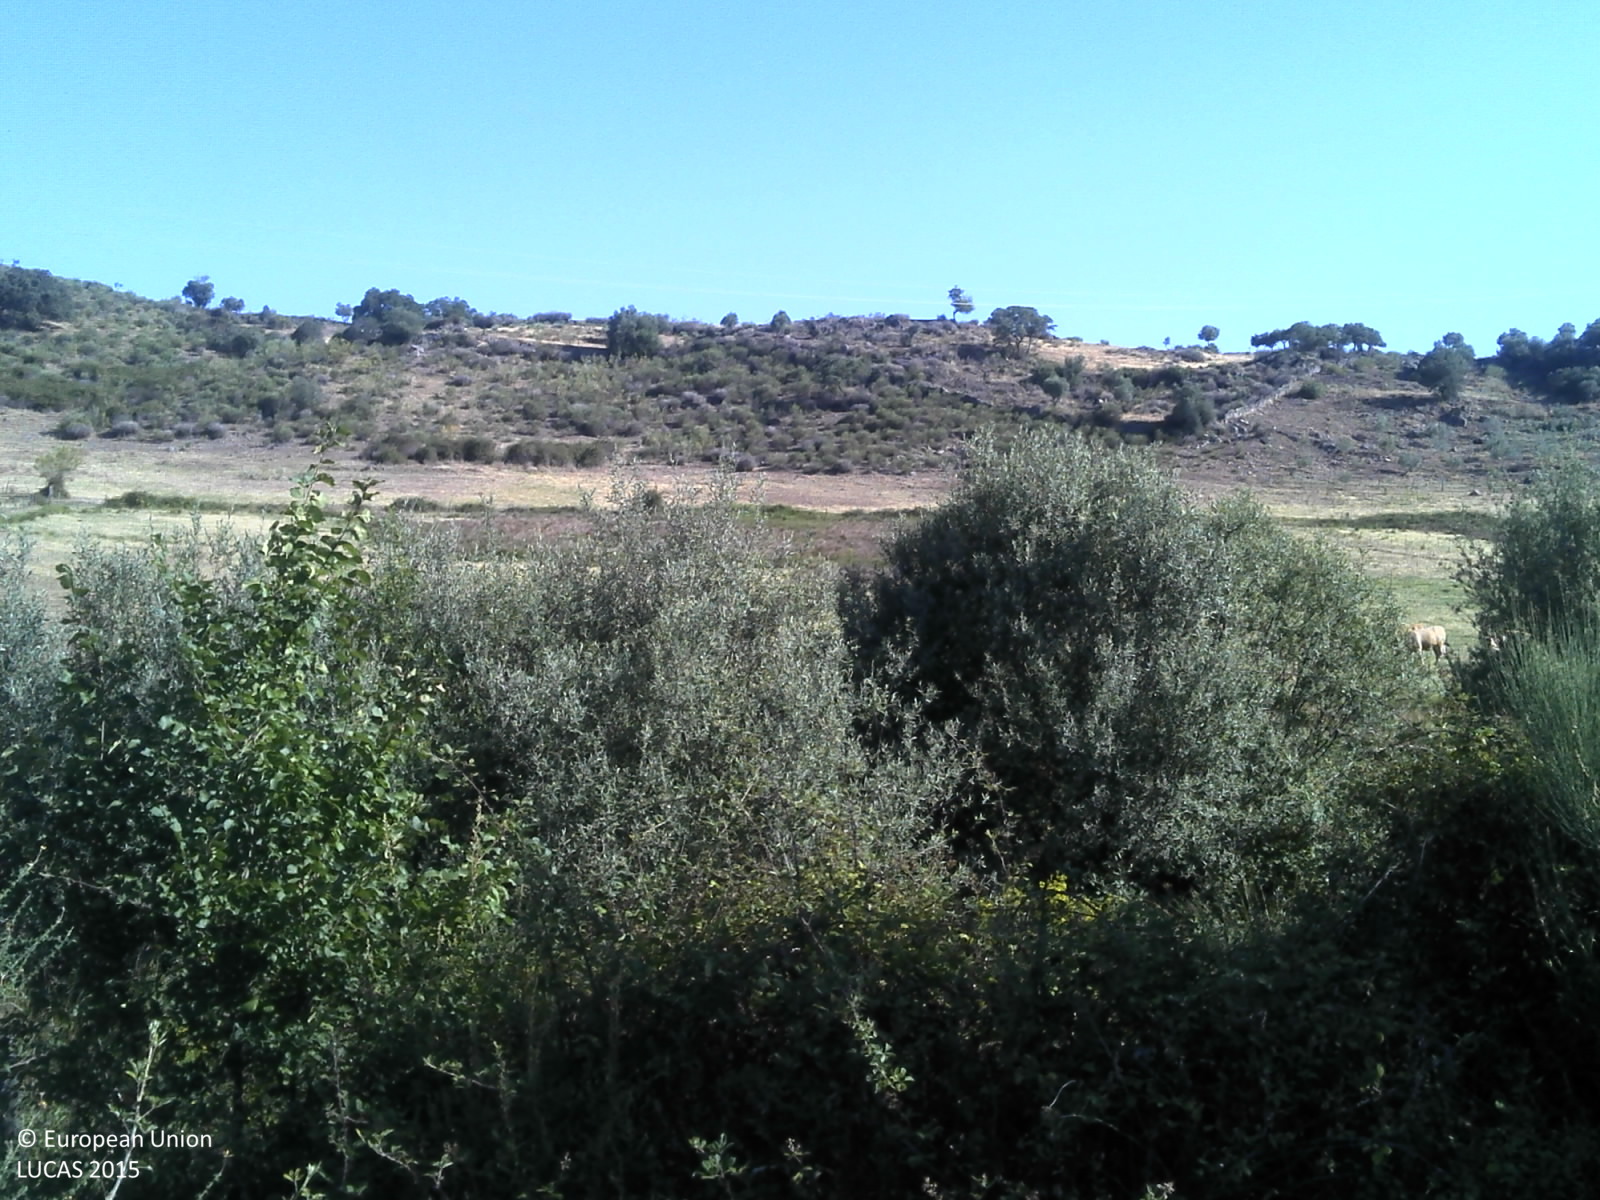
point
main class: Grassland
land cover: Grassland with sparse tree/shrub cover
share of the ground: 50 - 75 %
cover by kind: herbaceous plants 55 %, unconsolidated bare surface 30 %, broadleaved forest trees 5 %, shrubs 5 %
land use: Agriculture (excluding fallow land and kitchen gardens)
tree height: > 5 m
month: June
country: PT
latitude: 39.9104
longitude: -7.2319
